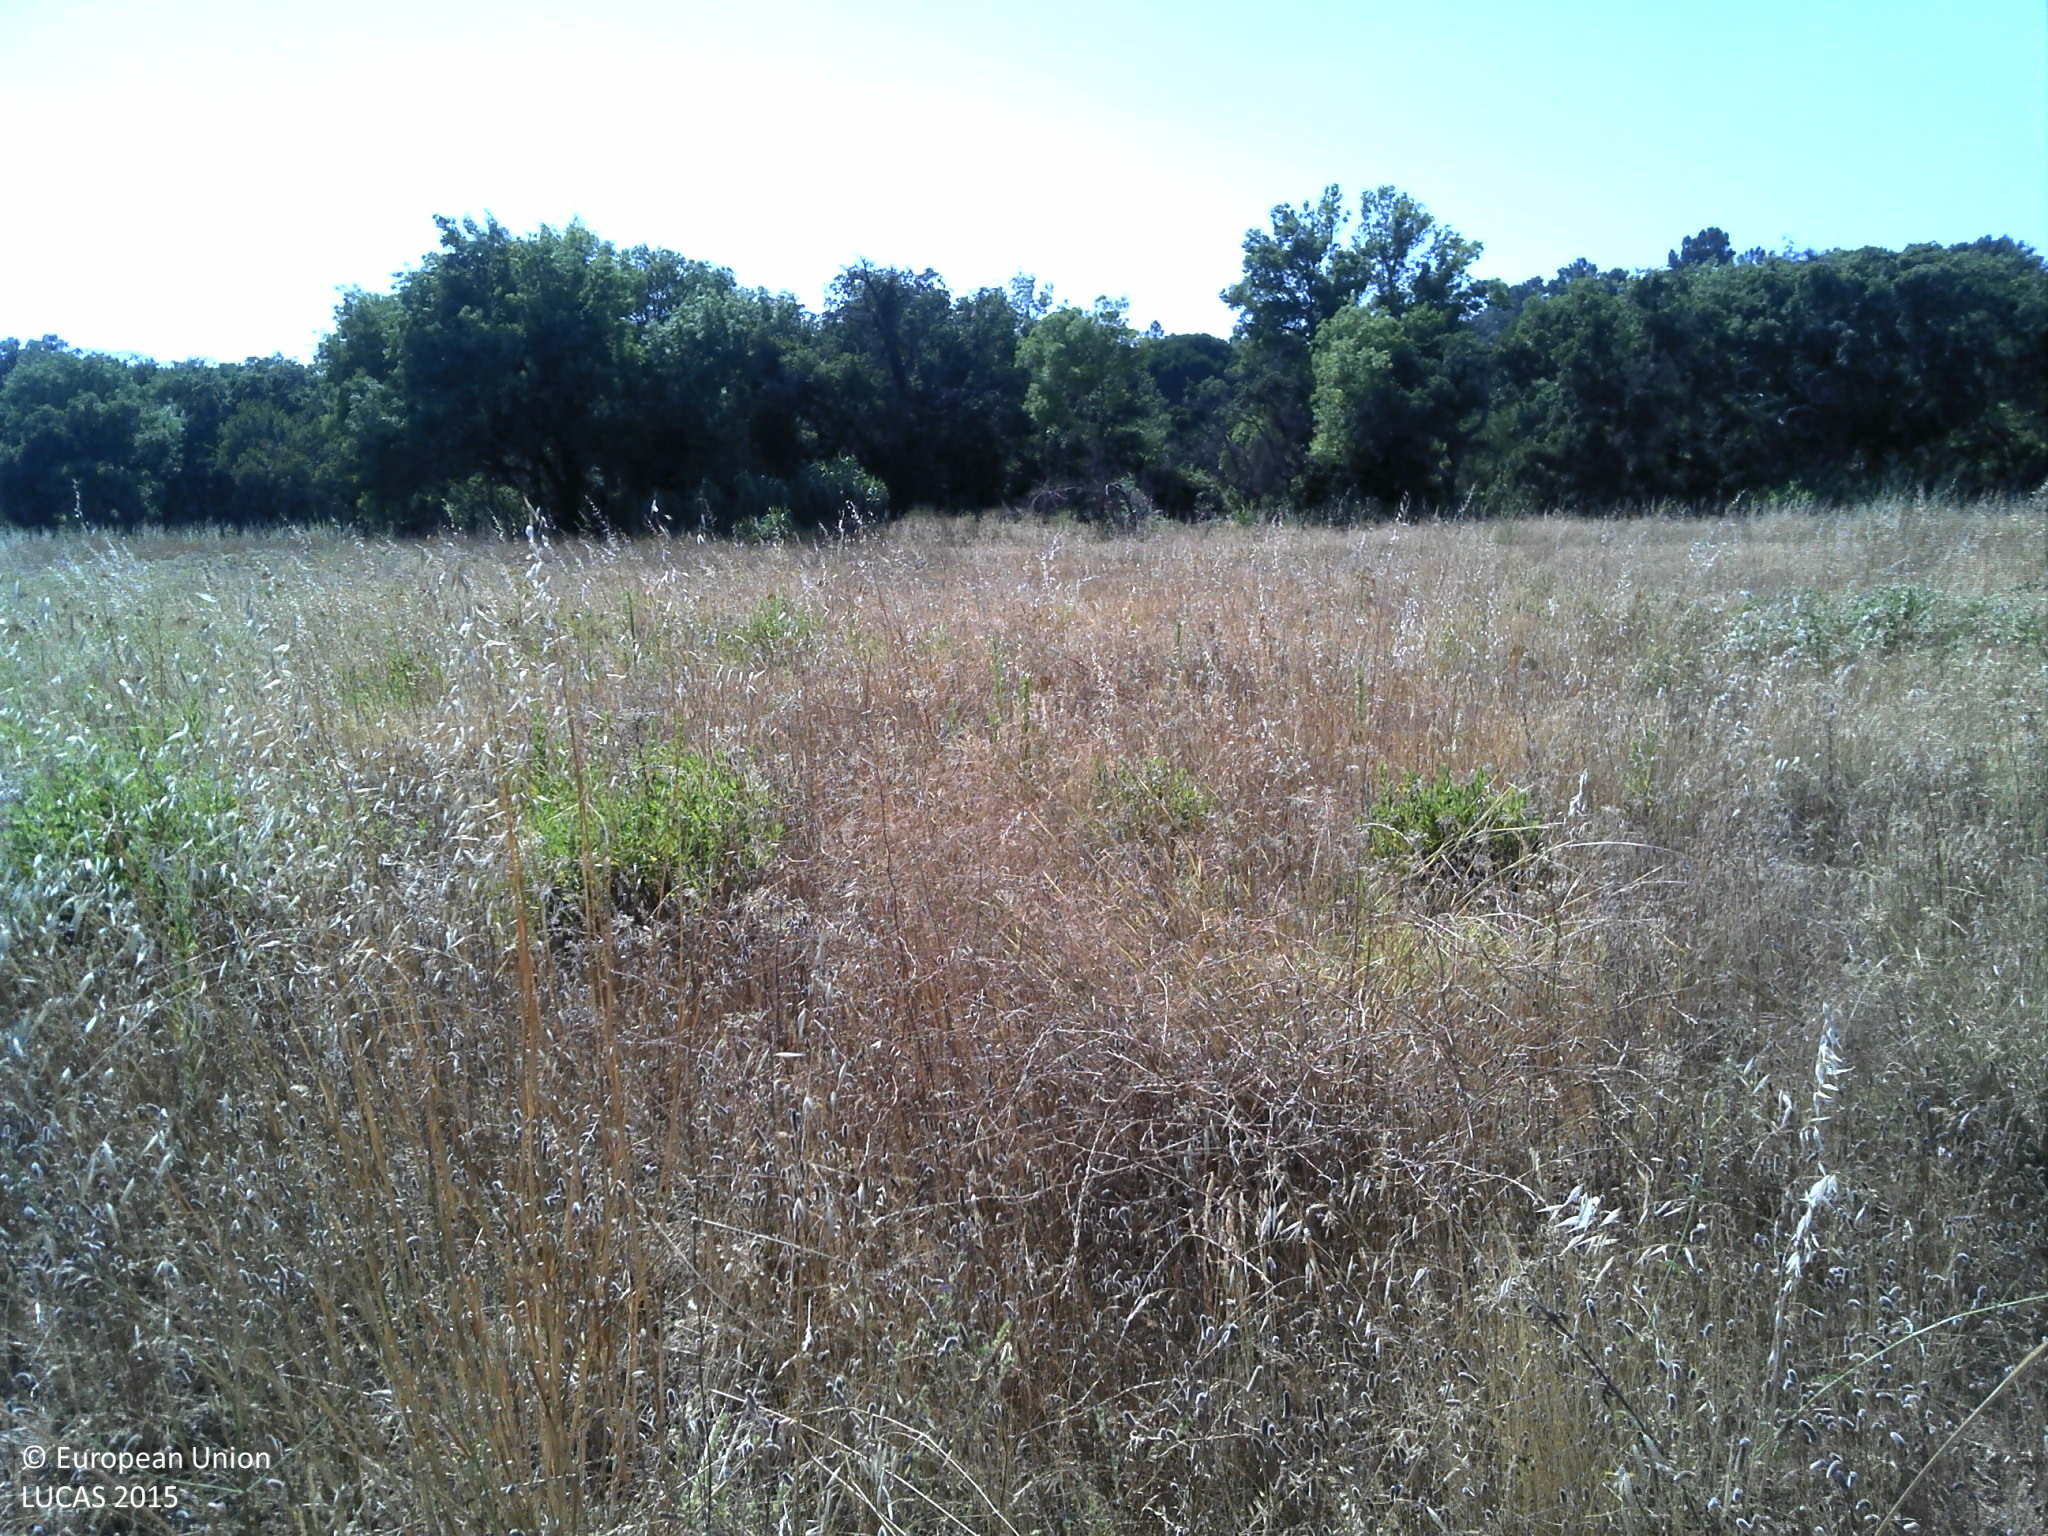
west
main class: Grassland
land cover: Spontaneously vegetated surfaces
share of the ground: 50 - 75 %
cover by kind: herbaceous plants 75 %, unconsolidated bare surface 25 %
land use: Fallow land
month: June
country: PT
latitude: 38.5112
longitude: -9.0481
